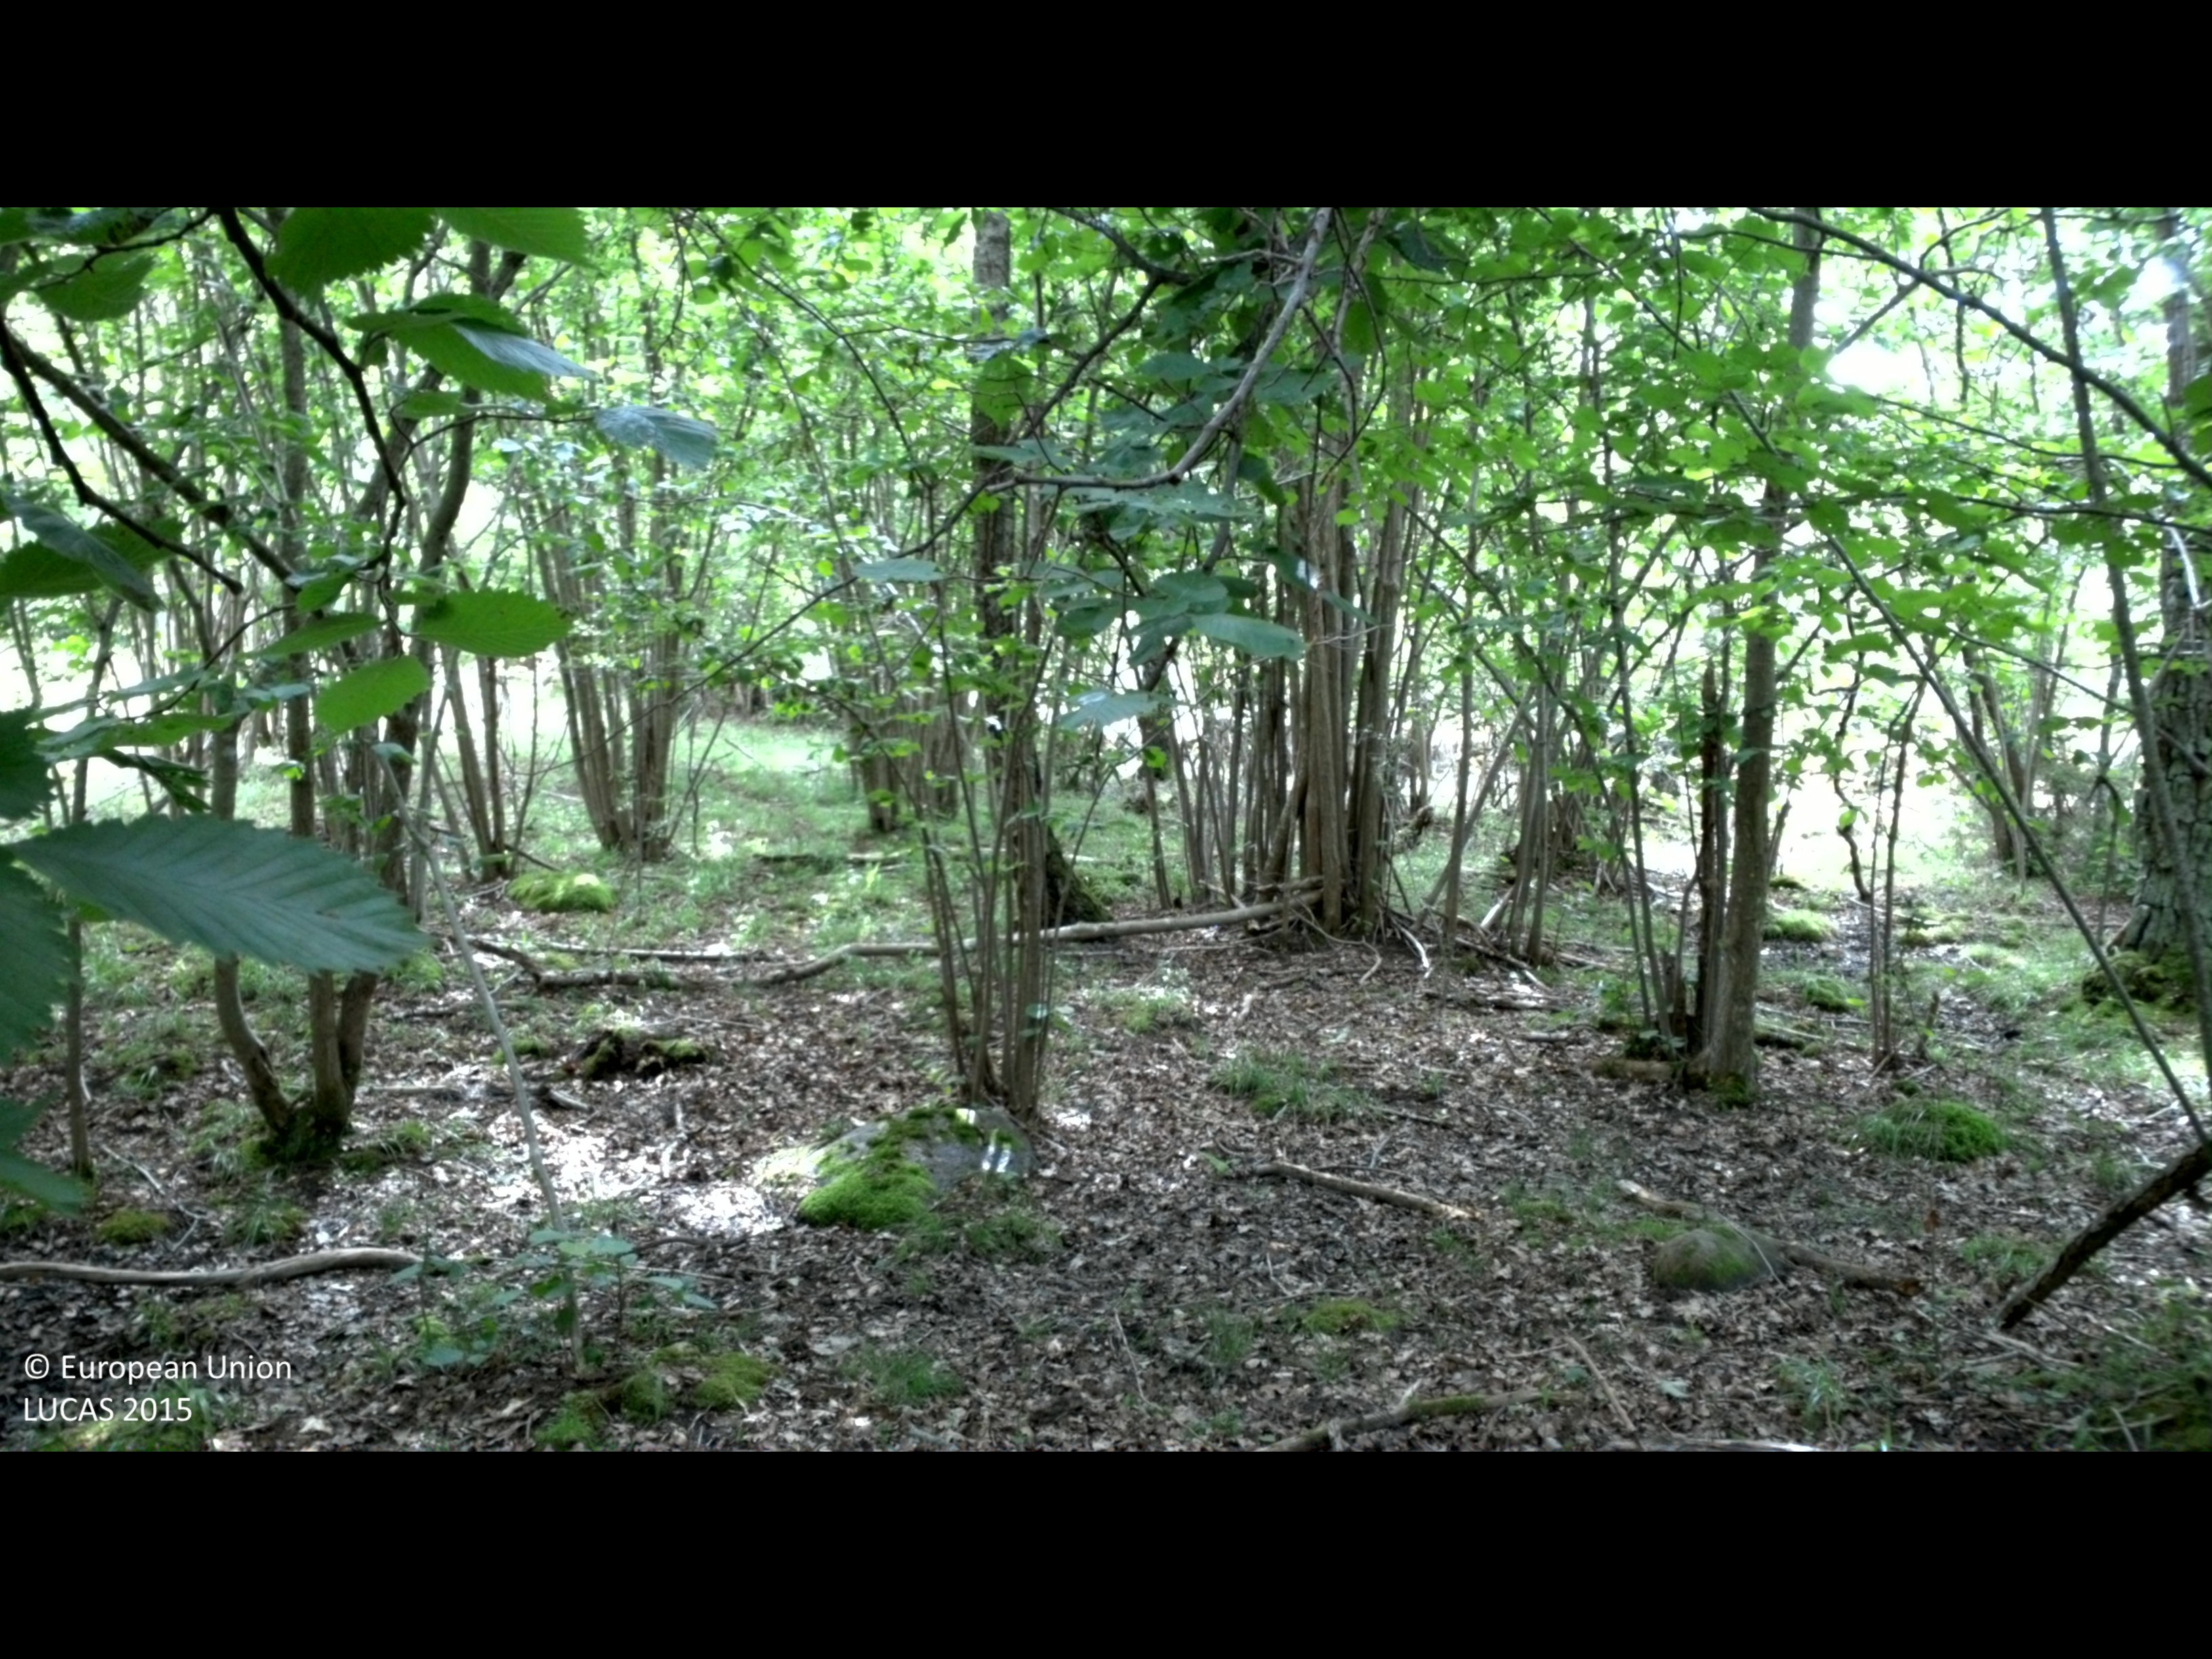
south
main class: Woodland
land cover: Broadleaved woodland
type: mesophytic deciduous forest
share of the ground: > 75 %
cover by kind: shrubs 55 %, broadleaved forest trees 40 %, herbaceous plants 5 %
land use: Forestry
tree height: > 5 m
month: July
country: SE
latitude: 56.7906
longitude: 16.6645
